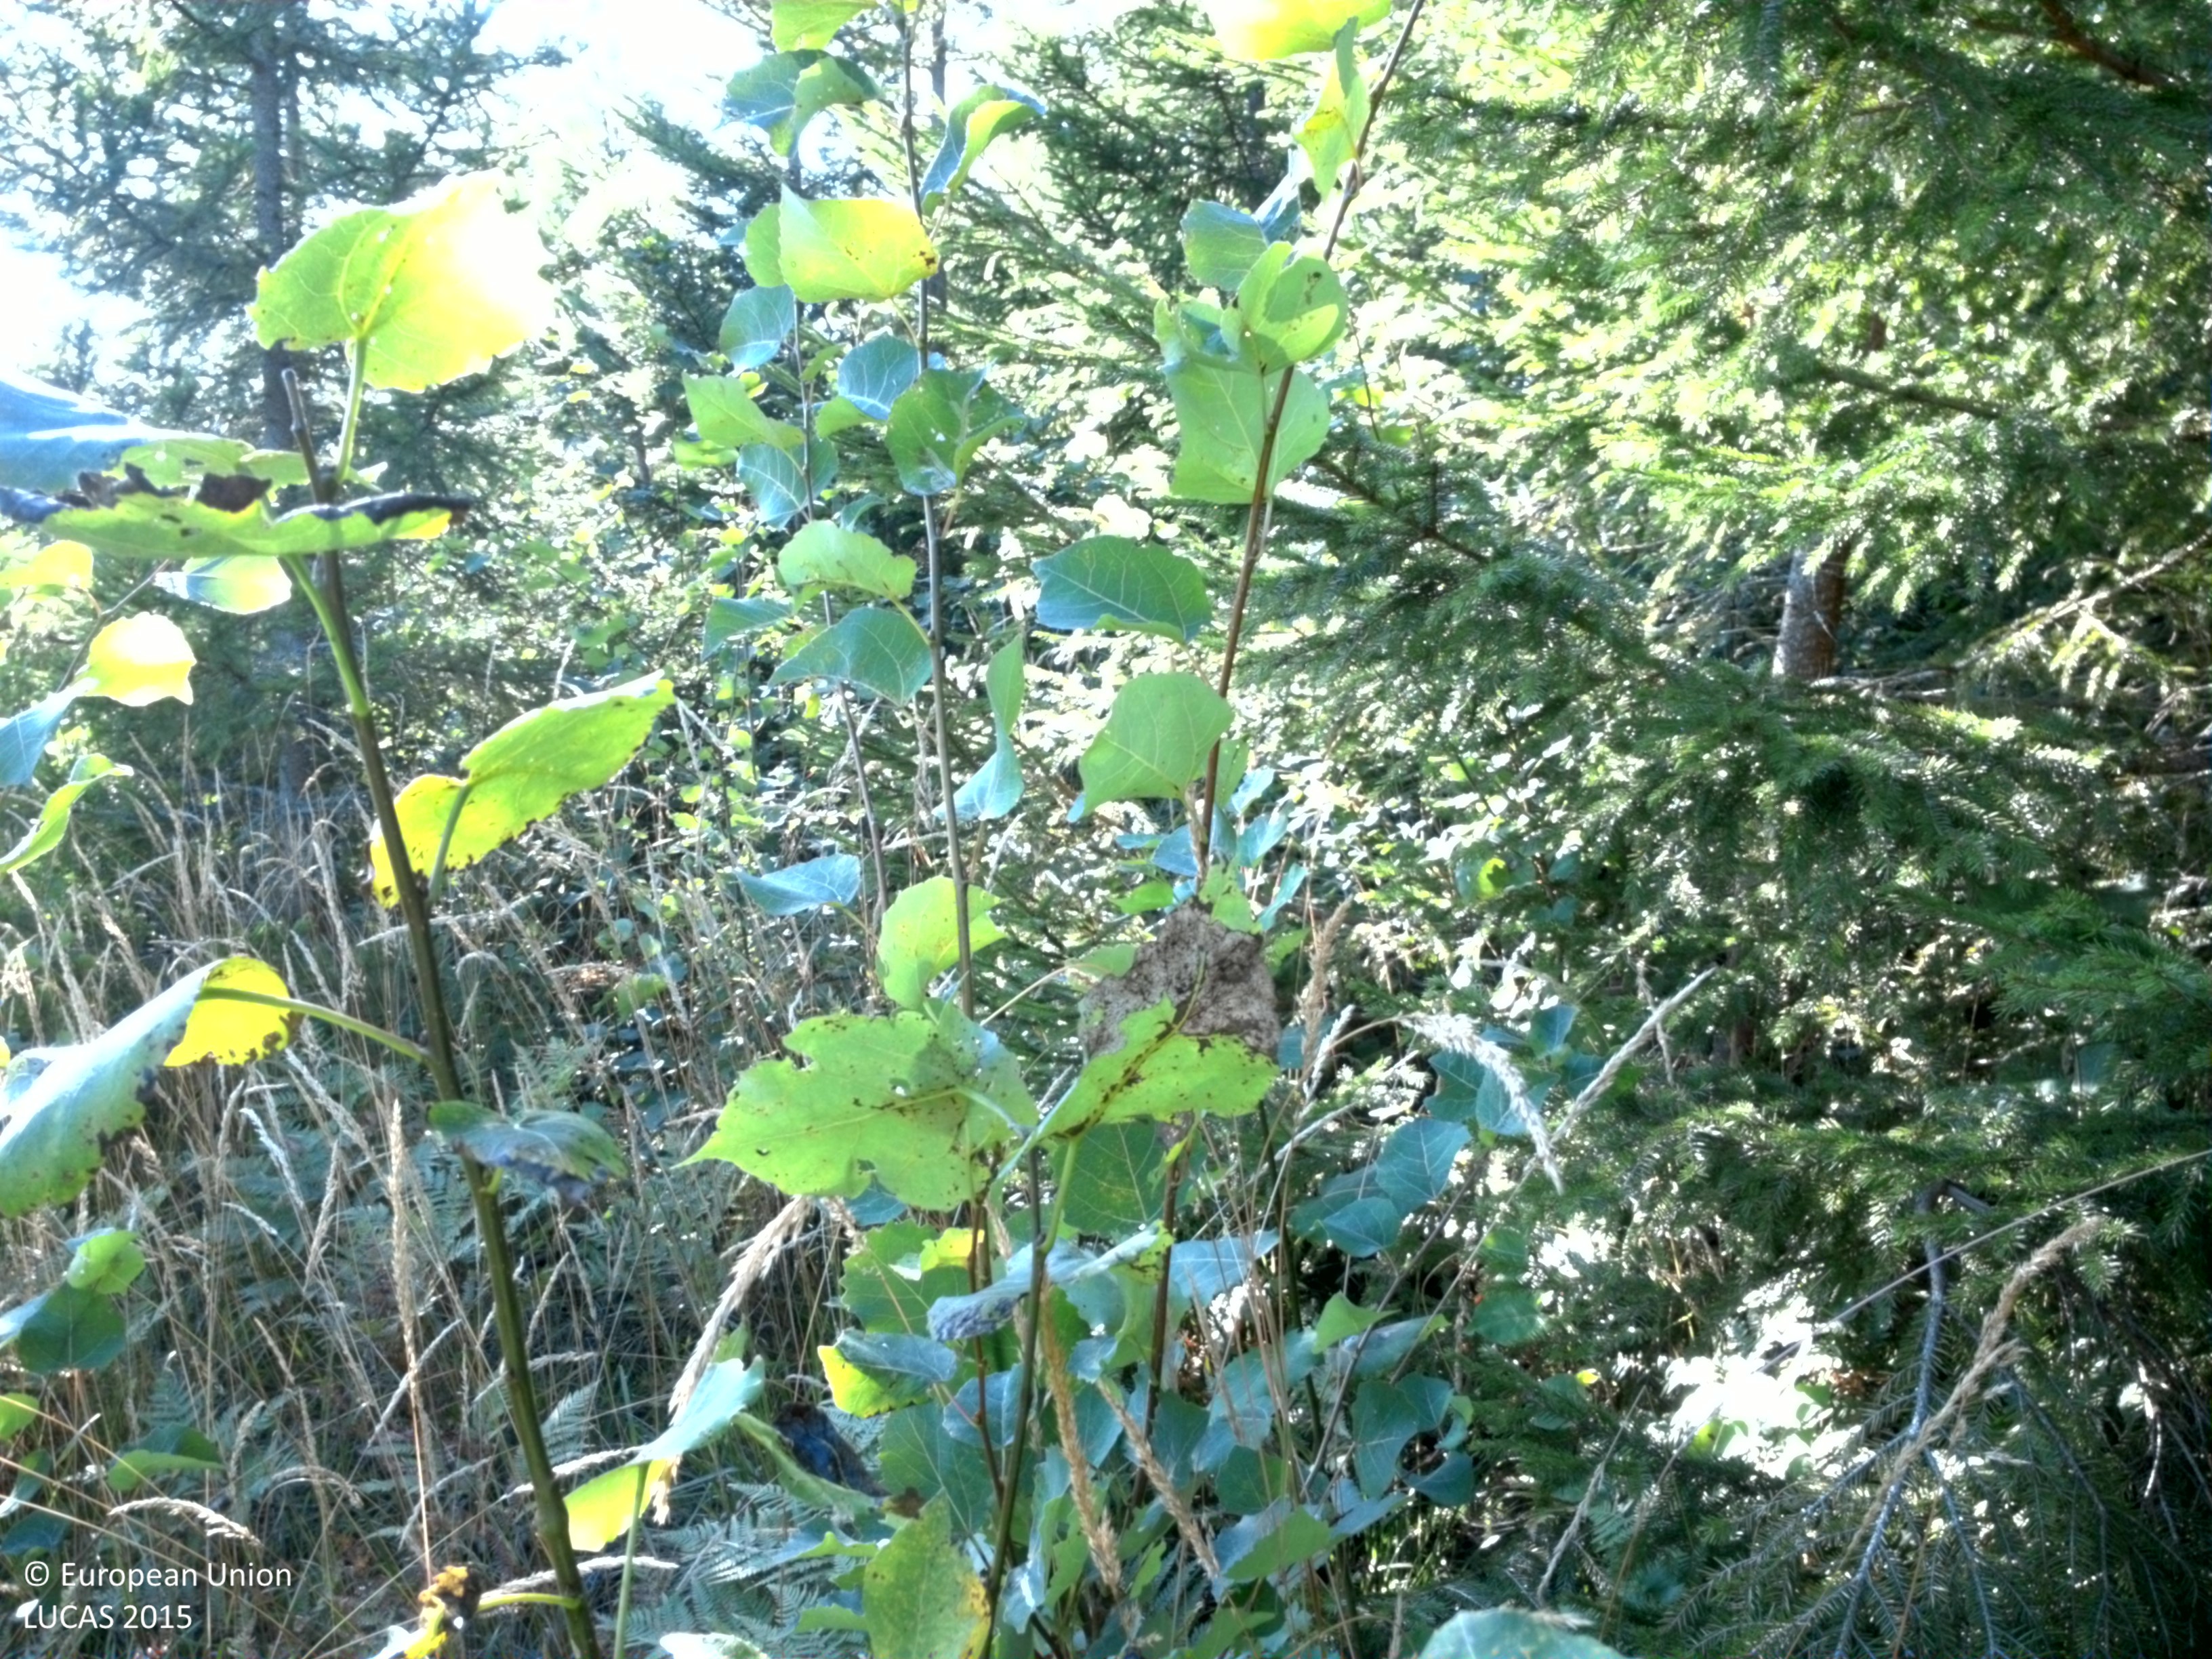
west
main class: Woodland
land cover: Spruce dominated mixed woodland
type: boreal forest
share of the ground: > 75 %
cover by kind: broadleaved forest trees 50 %, coniferous forest trees 40 %, herbaceous plants 10 %
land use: Forestry
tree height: > 5 m
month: August
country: SE
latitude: 59.5868
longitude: 15.9240
